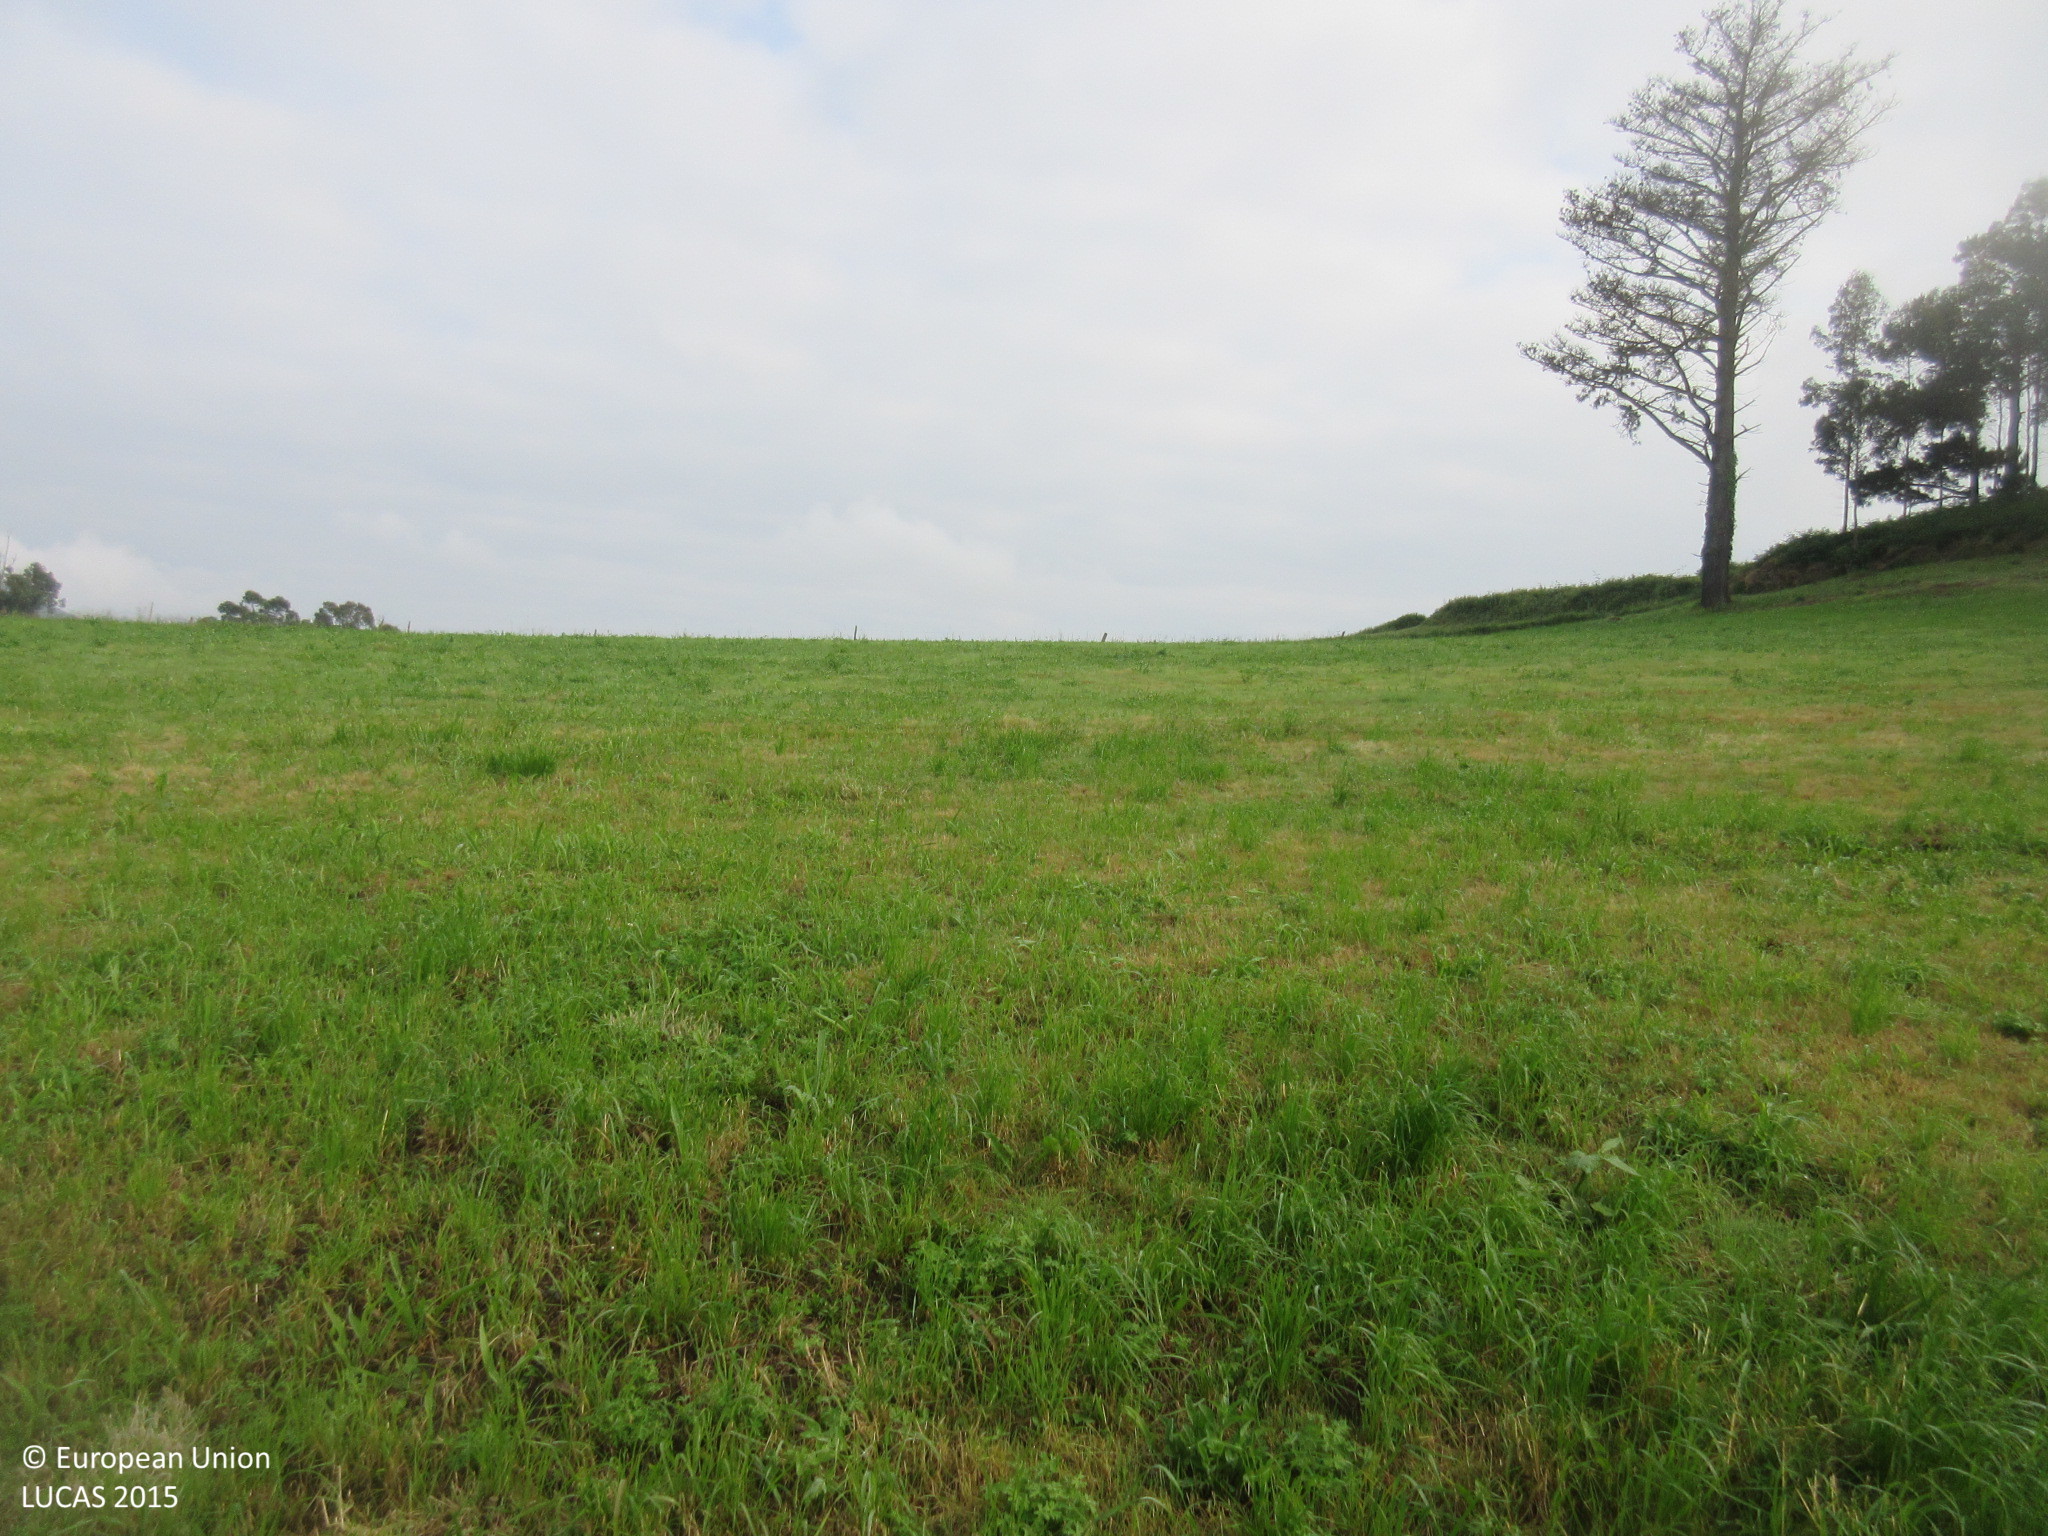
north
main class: Grassland
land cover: Grassland without tree/shrub cover
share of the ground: > 75 %
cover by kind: herbaceous plants 100 %
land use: Agriculture (excluding fallow land and kitchen gardens)
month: June
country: ES
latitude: 43.4642
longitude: -5.8986
